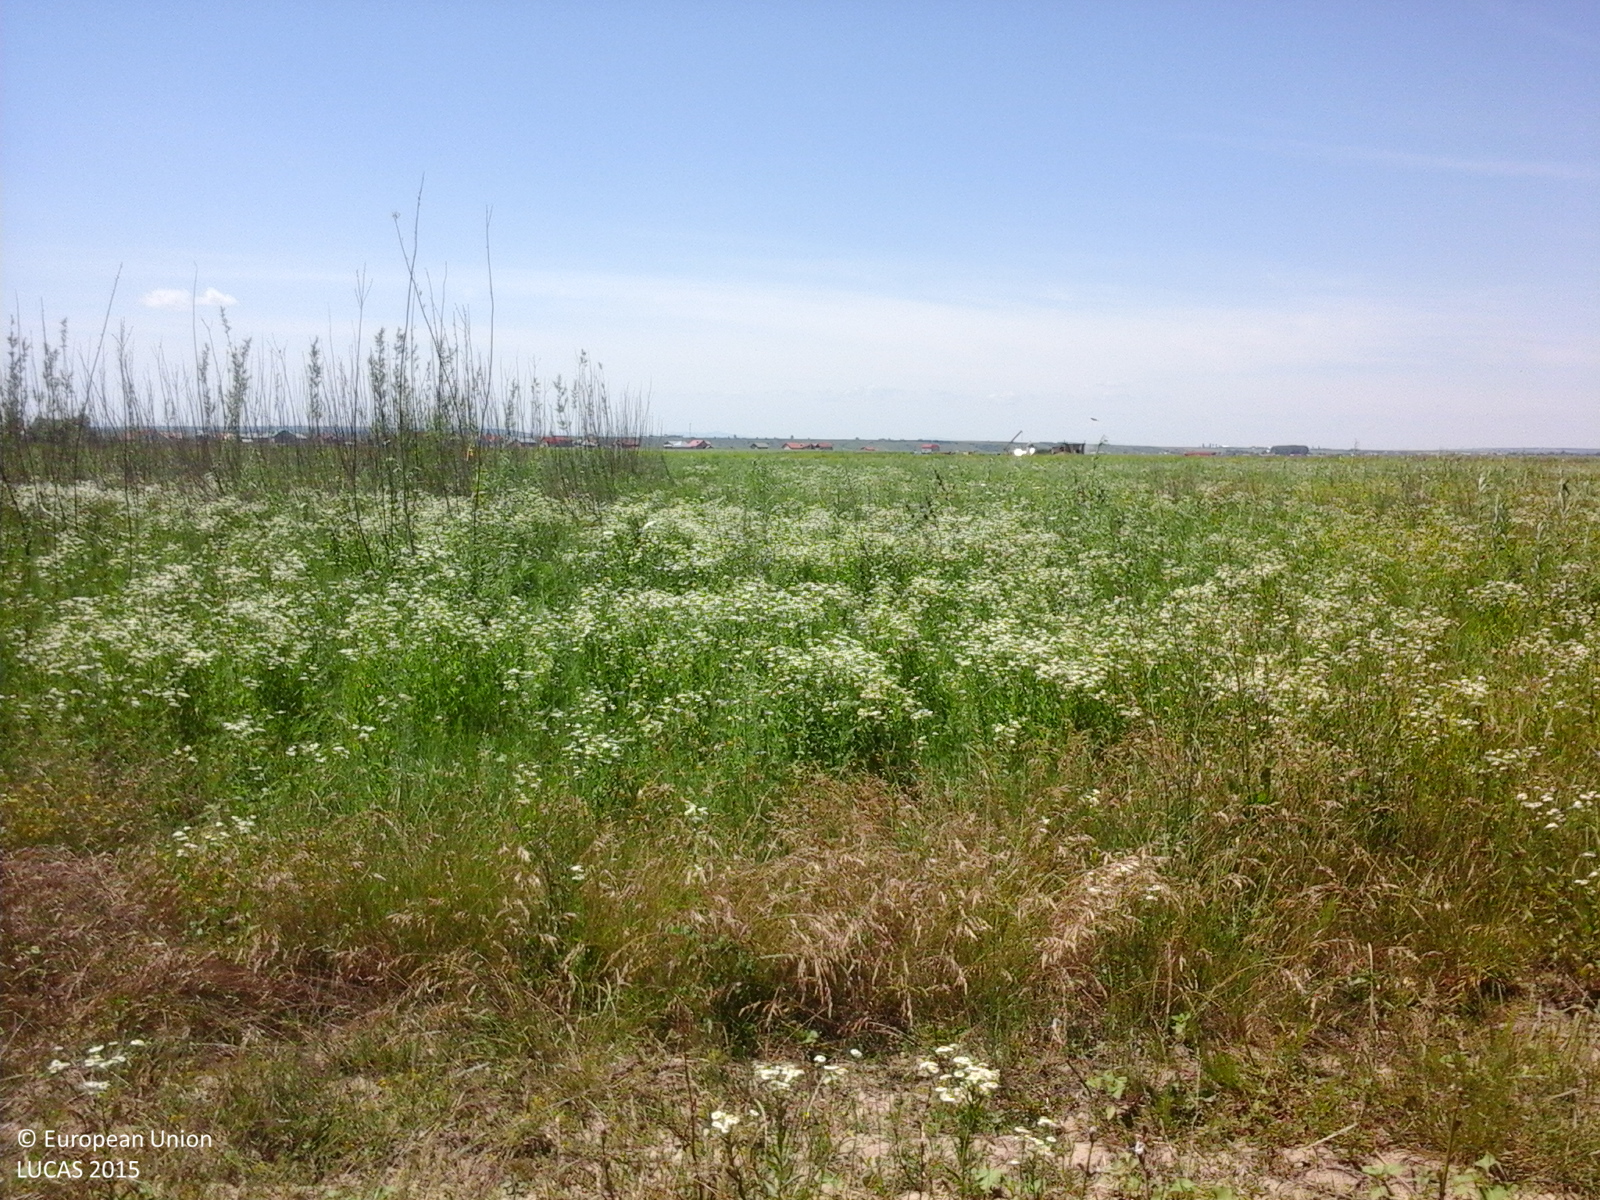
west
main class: Grassland
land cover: Grassland without tree/shrub cover
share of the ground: > 75 %
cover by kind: herbaceous plants 100 %
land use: Agriculture (excluding fallow land and kitchen gardens)
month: June
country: RO
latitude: 47.0262
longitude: 26.9533
